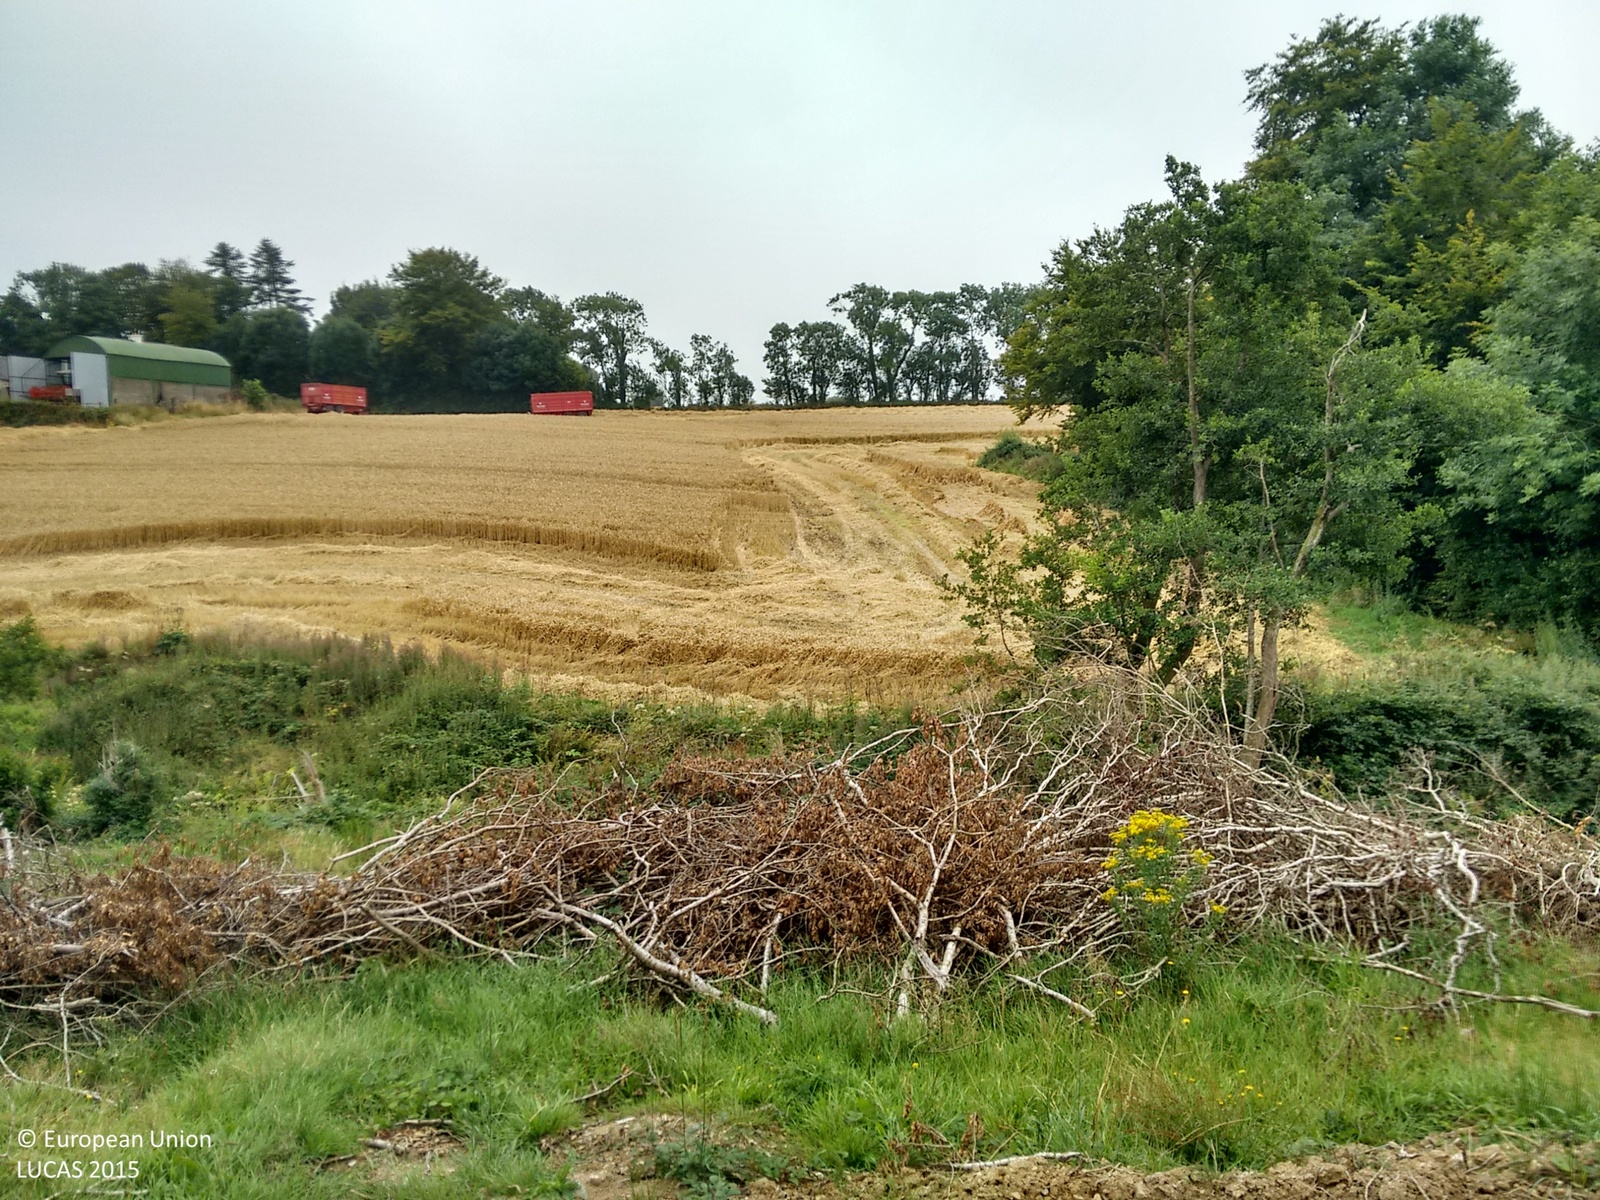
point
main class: Cropland
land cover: Barley
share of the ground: > 75 %
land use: Agriculture (excluding fallow land and kitchen gardens)
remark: Harvested field
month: August
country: IE
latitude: 52.4554
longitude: -6.5371
